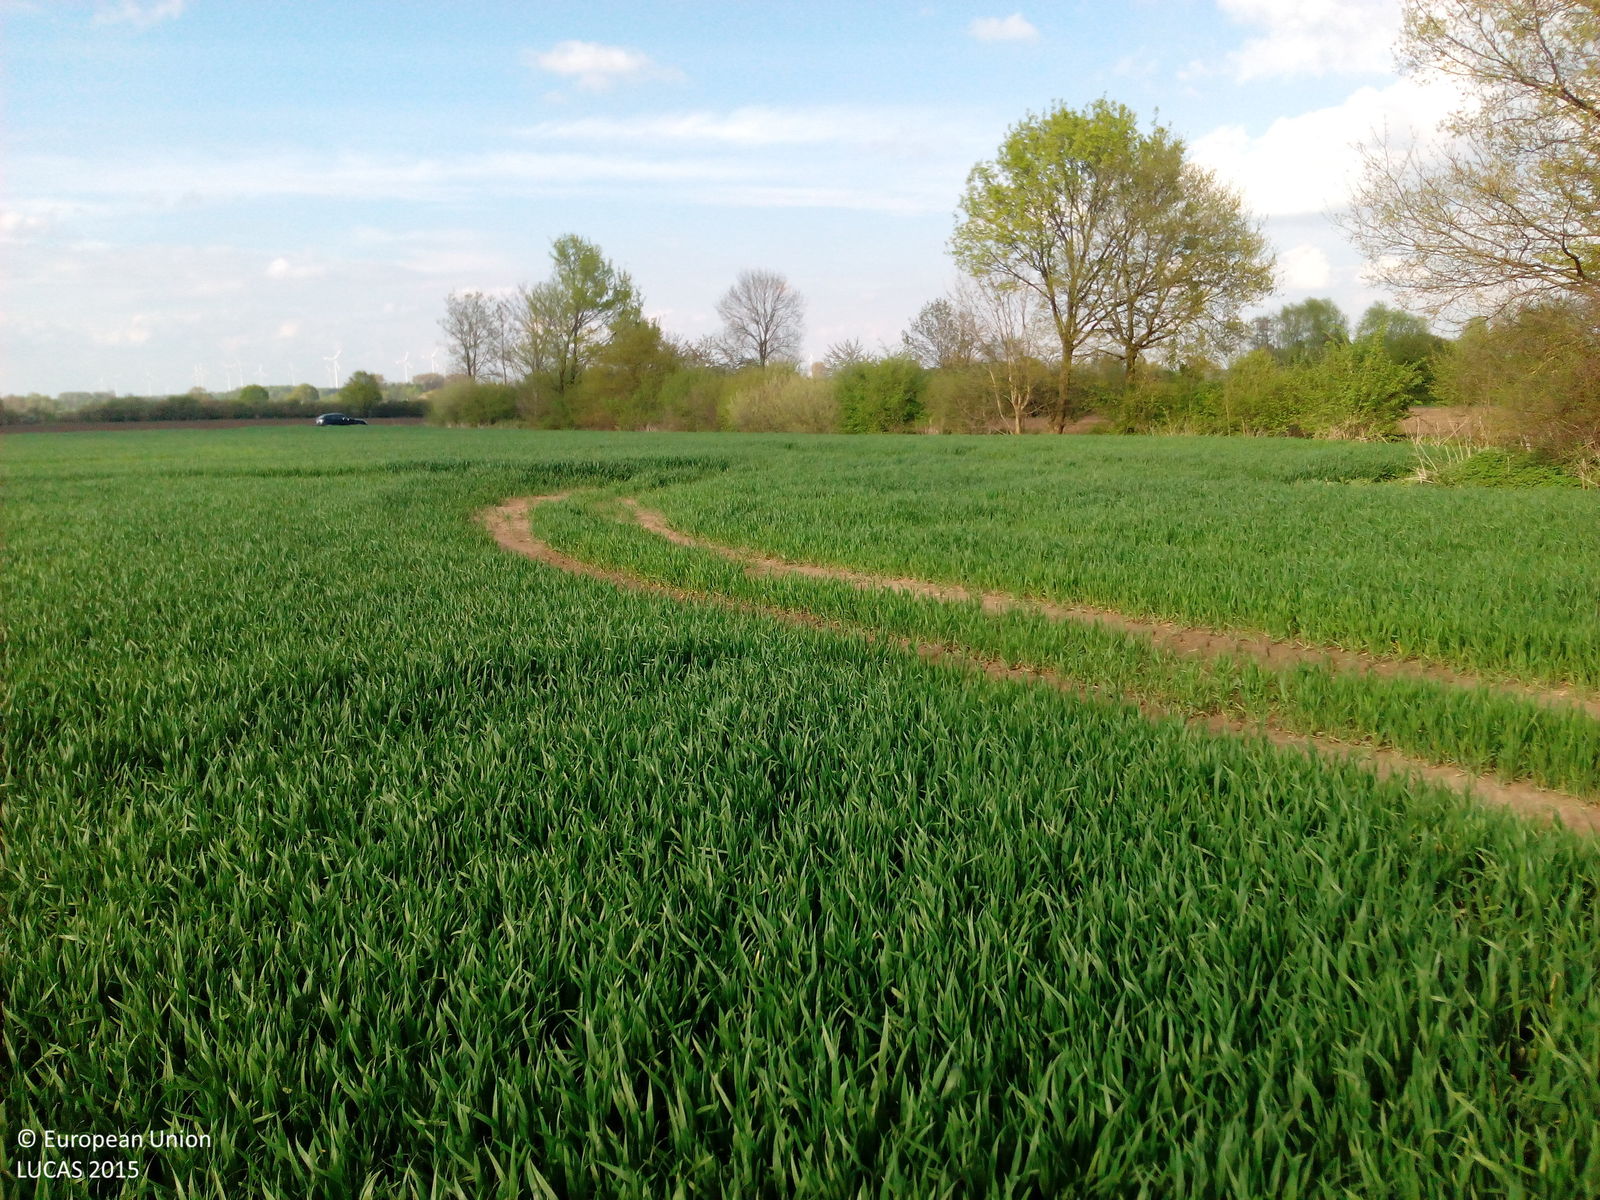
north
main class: Cropland
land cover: Triticale
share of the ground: > 75 %
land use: Agriculture (excluding fallow land and kitchen gardens)
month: May
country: DE
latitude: 52.0251
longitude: 7.3915
